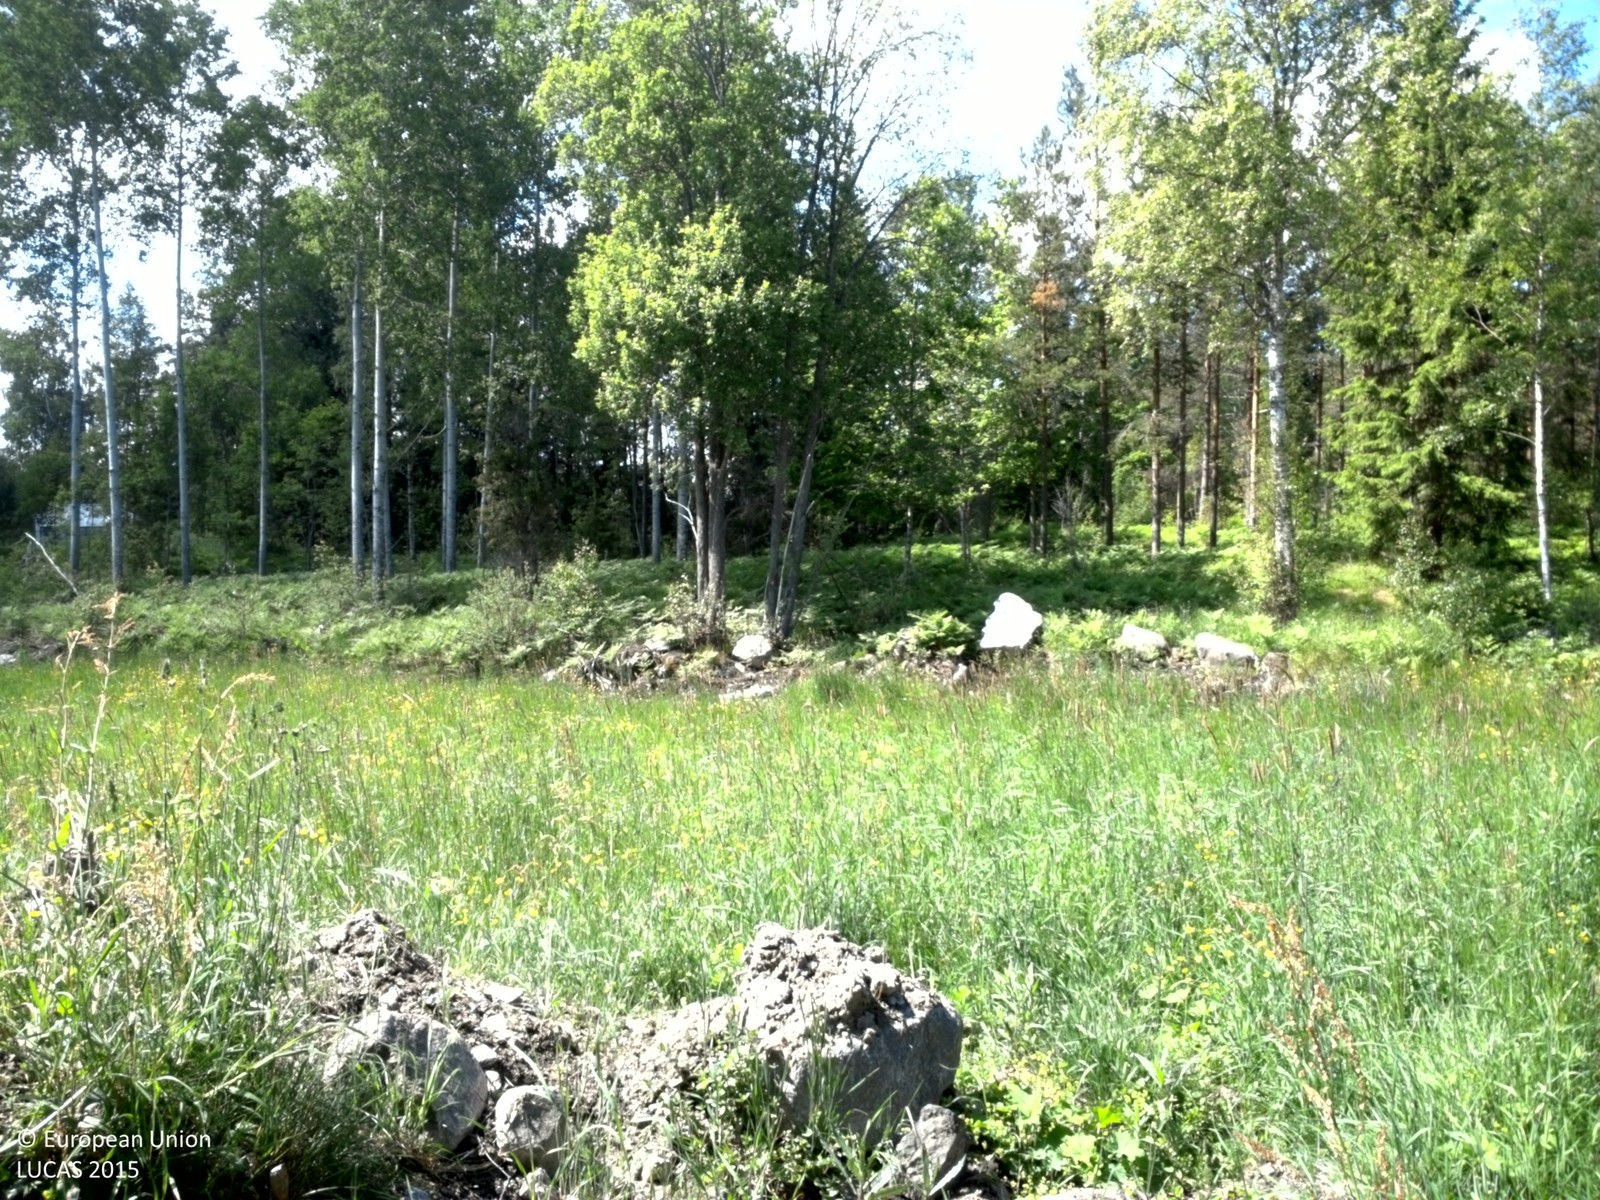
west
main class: Grassland
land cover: Grassland without tree/shrub cover
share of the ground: 25 - 50 %
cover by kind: unconsolidated bare surface 60 %, herbaceous plants 40 %
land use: Semi-natural and natural areas not in use
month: June
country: SE
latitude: 60.0983
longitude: 18.6118
